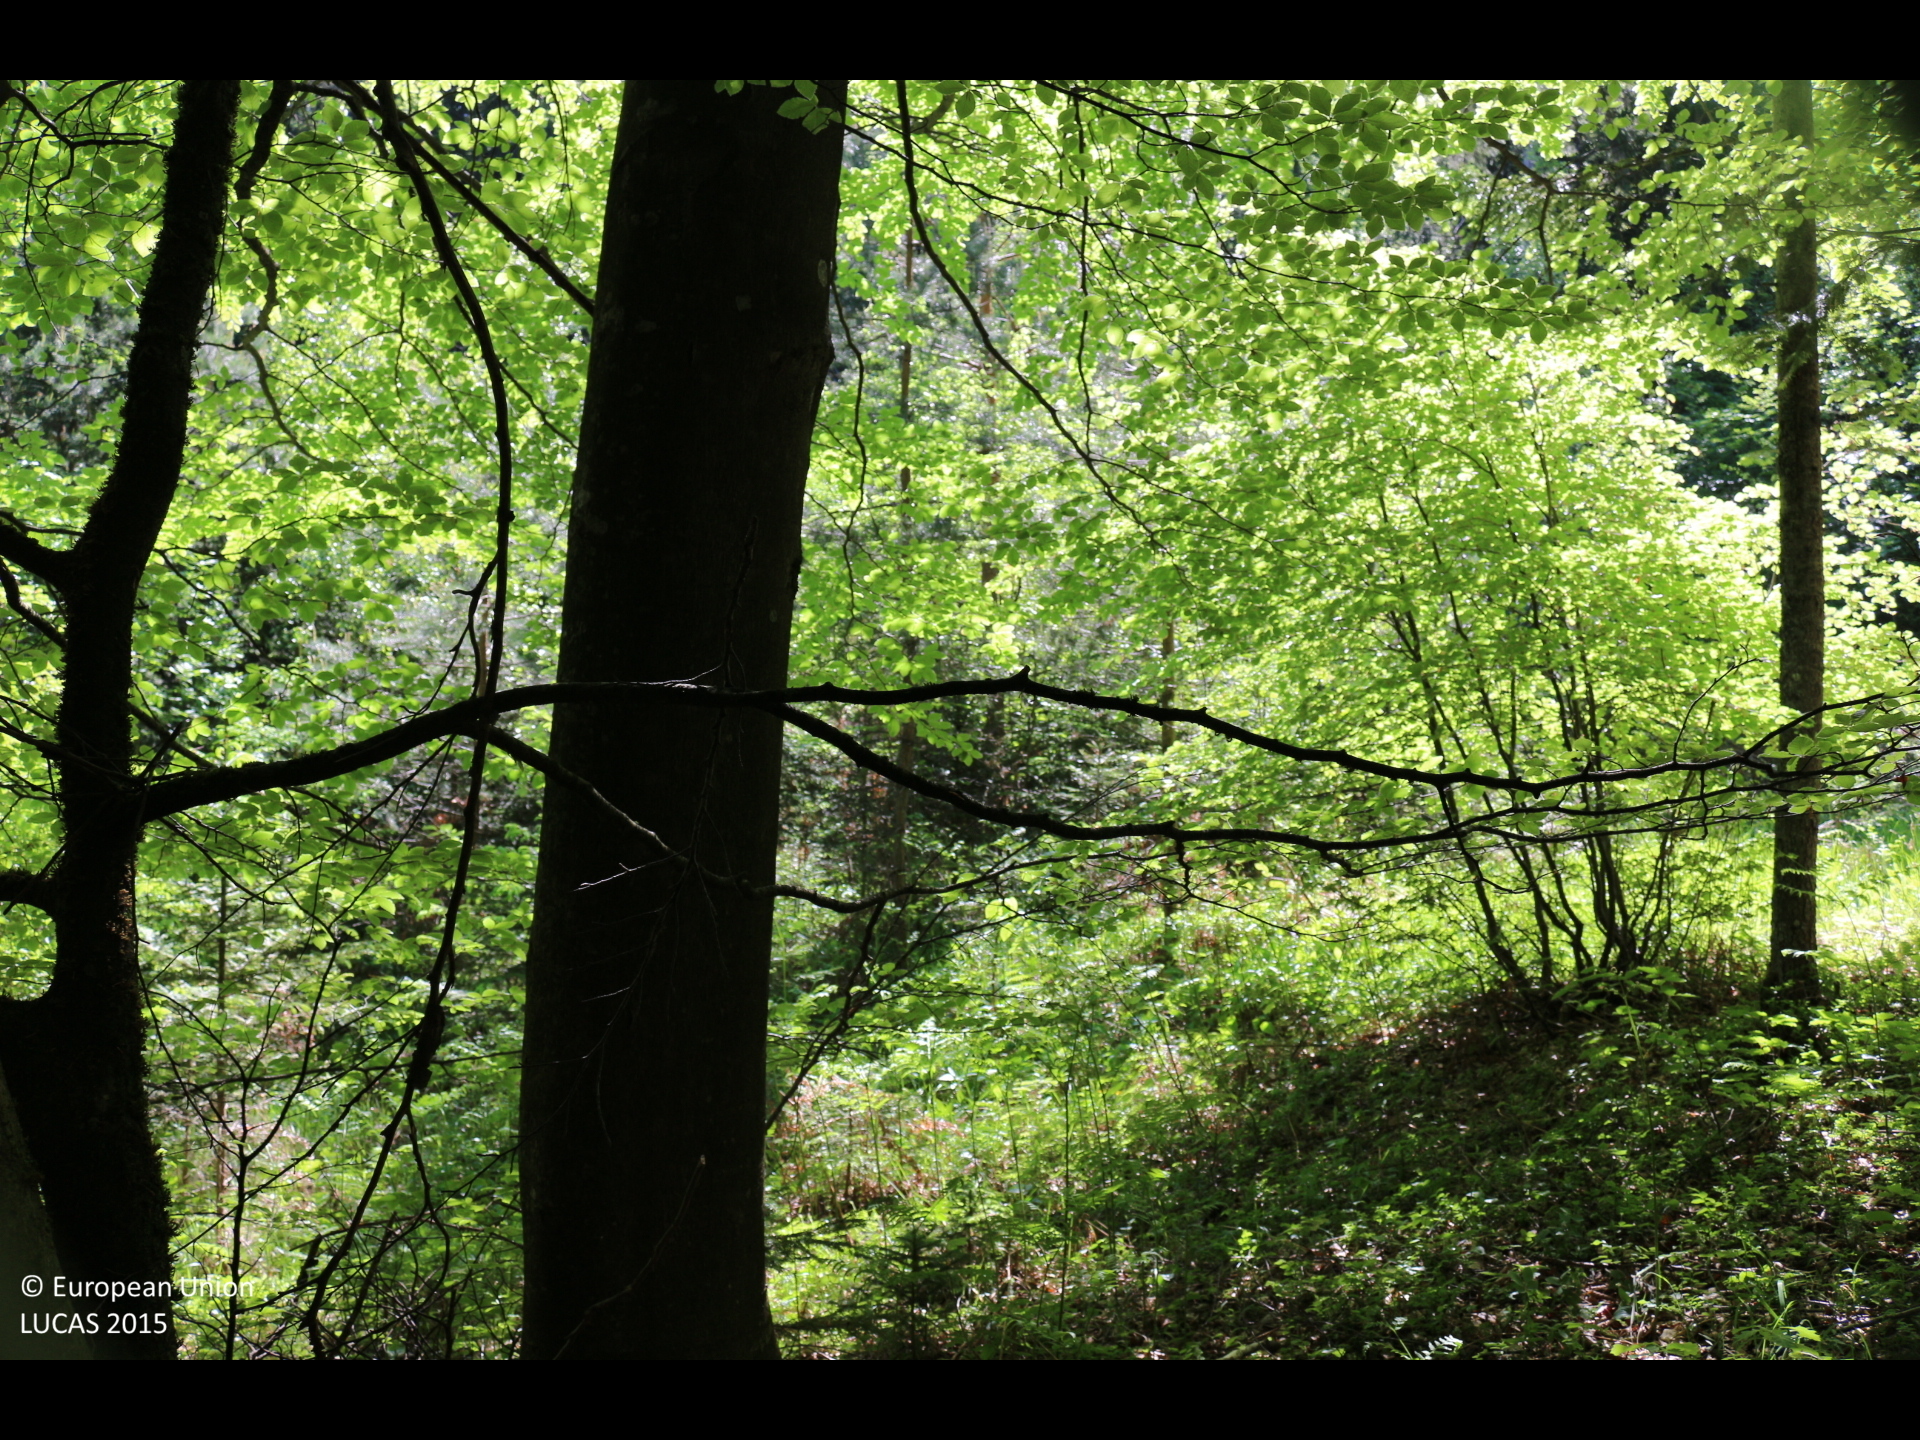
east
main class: Woodland
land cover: Spruce dominated mixed woodland
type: mountainous beech forest
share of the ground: > 75 %
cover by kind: coniferous forest trees 60 %, broadleaved forest trees 40 %
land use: Forestry
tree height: > 5 m
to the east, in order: Spruce dominated mixed woodland; Other mixed woodland; Tracks; Other mixed woodland; Tracks; Pine dominated mixed woodland; Other mixed woodland
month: May
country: AT
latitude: 46.5168
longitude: 14.3116
